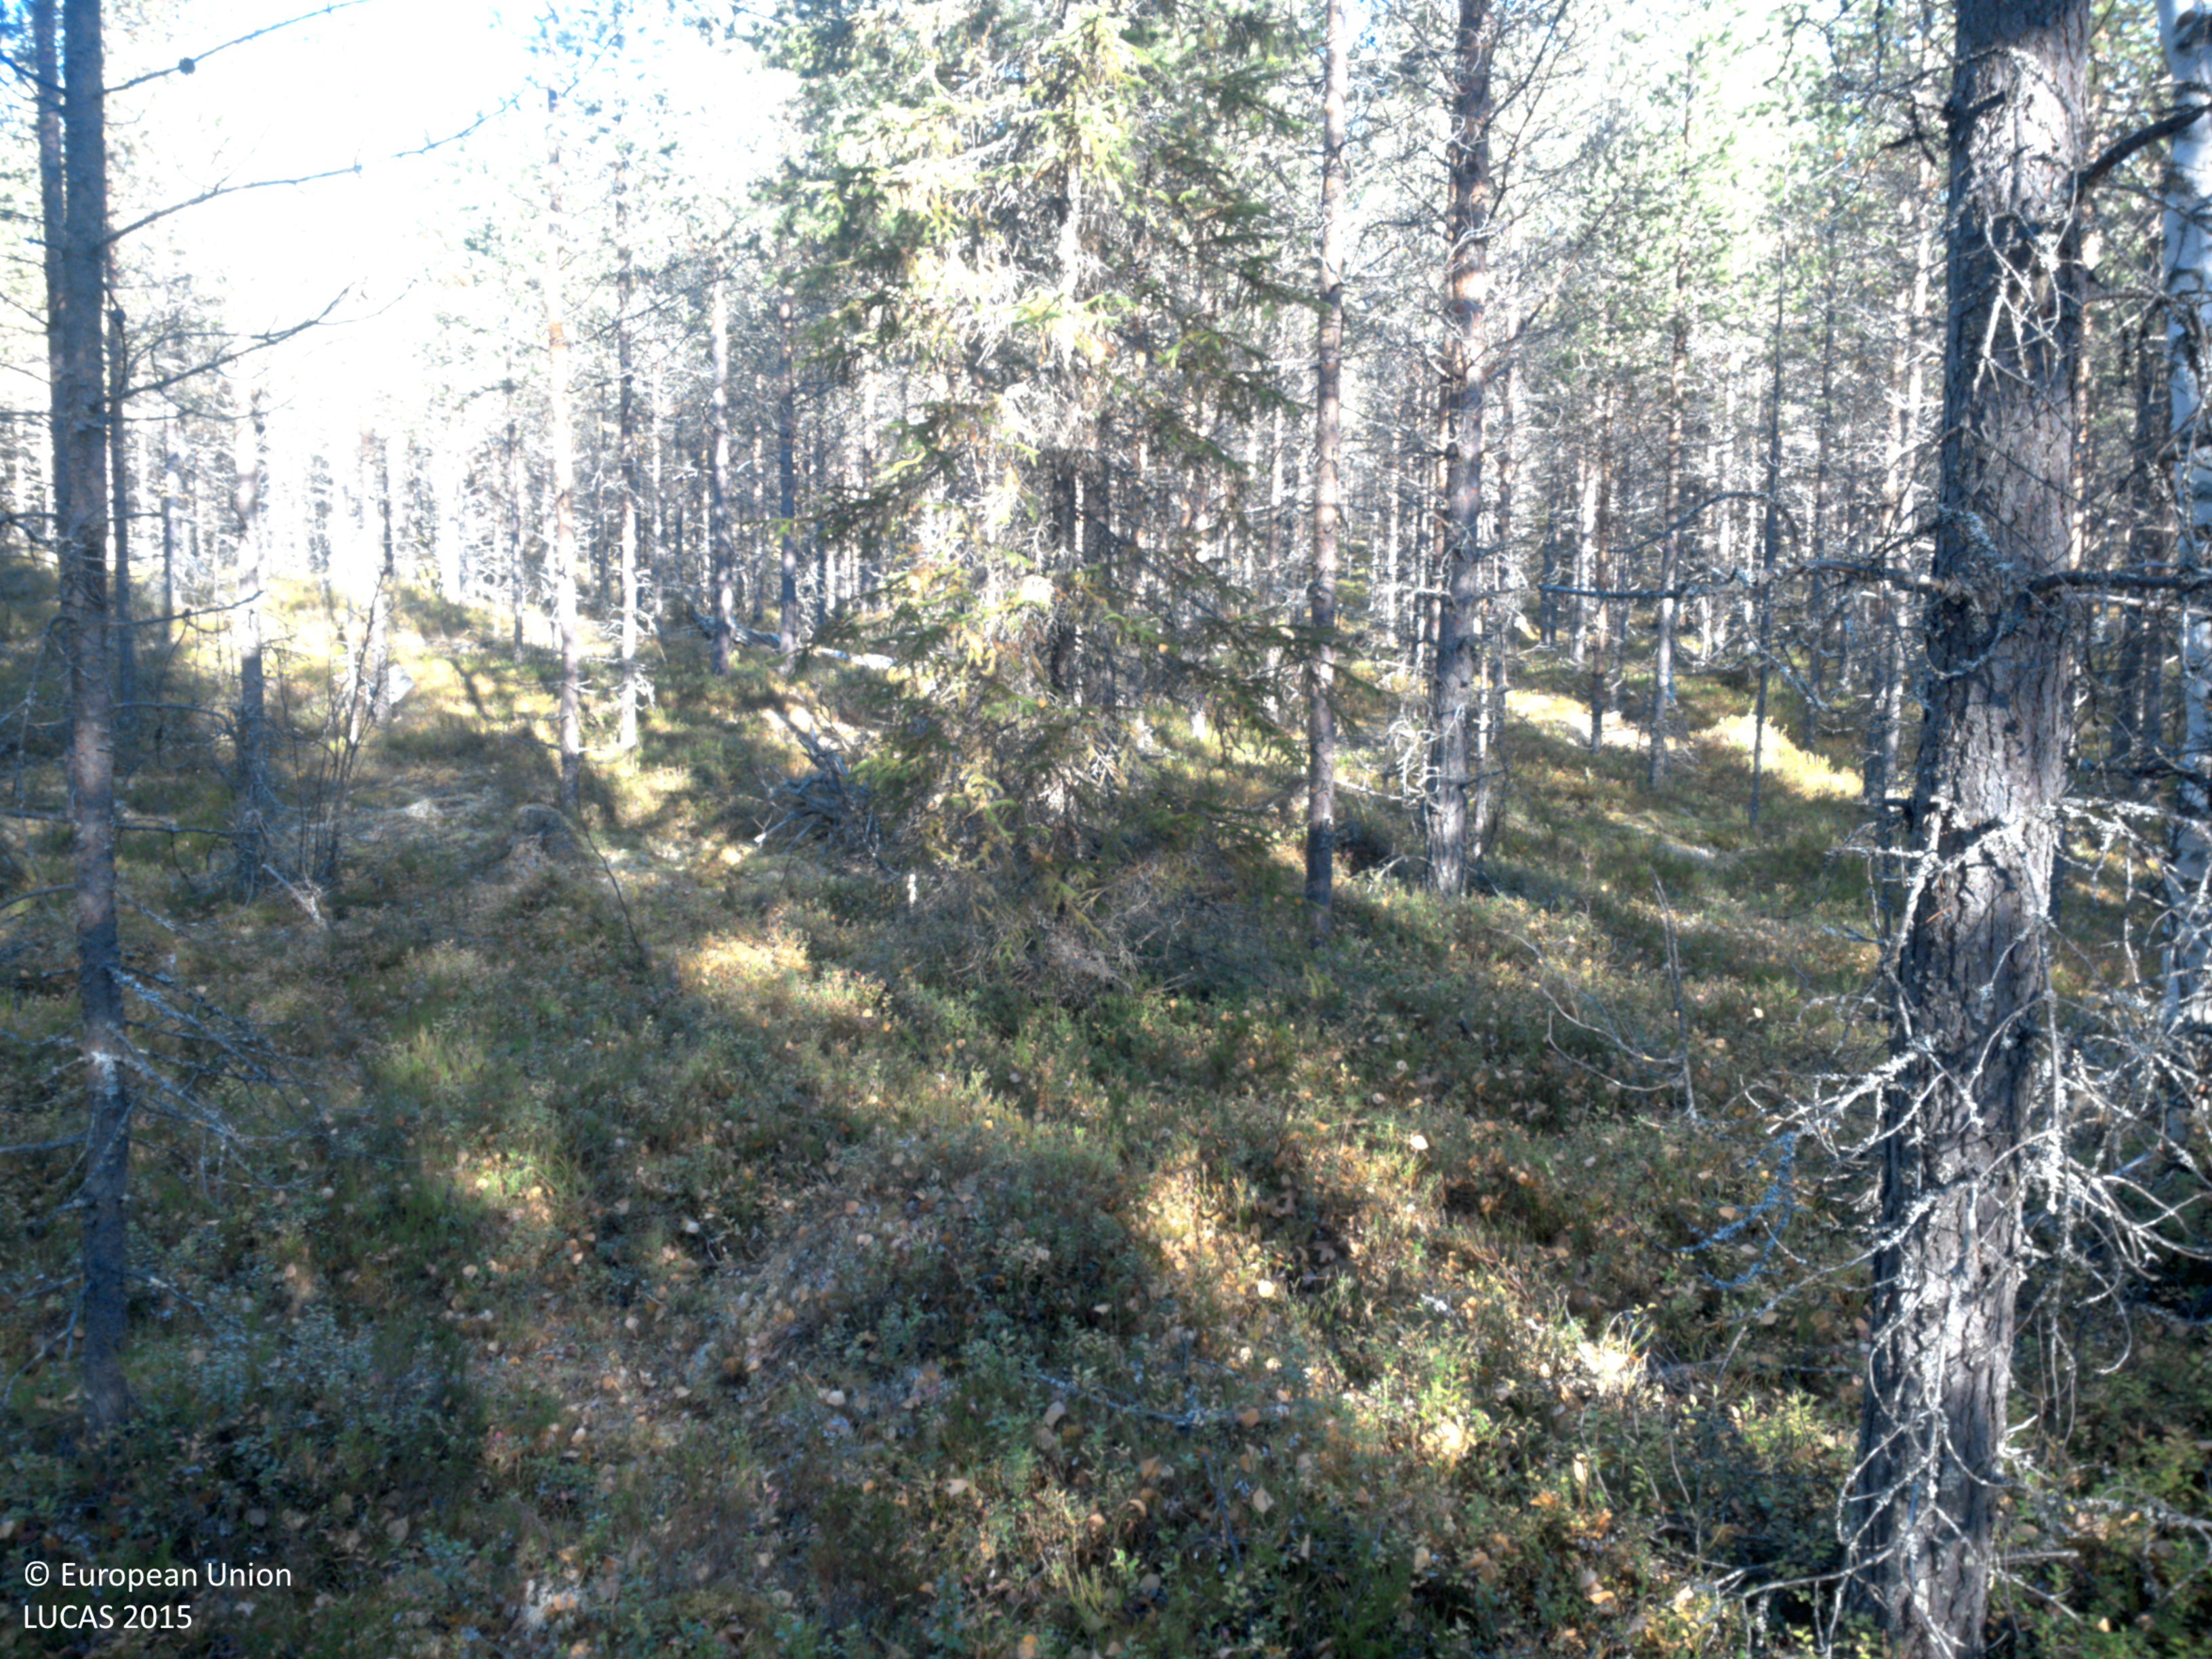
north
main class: Woodland
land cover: Pine dominated coniferous woodland
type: boreal forest
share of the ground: > 75 %
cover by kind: coniferous forest trees 80 %, shrubs 15 %, lichens and mosses 5 %
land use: Forestry
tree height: > 5 m
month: October
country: SE
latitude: 64.8134
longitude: 18.3685
